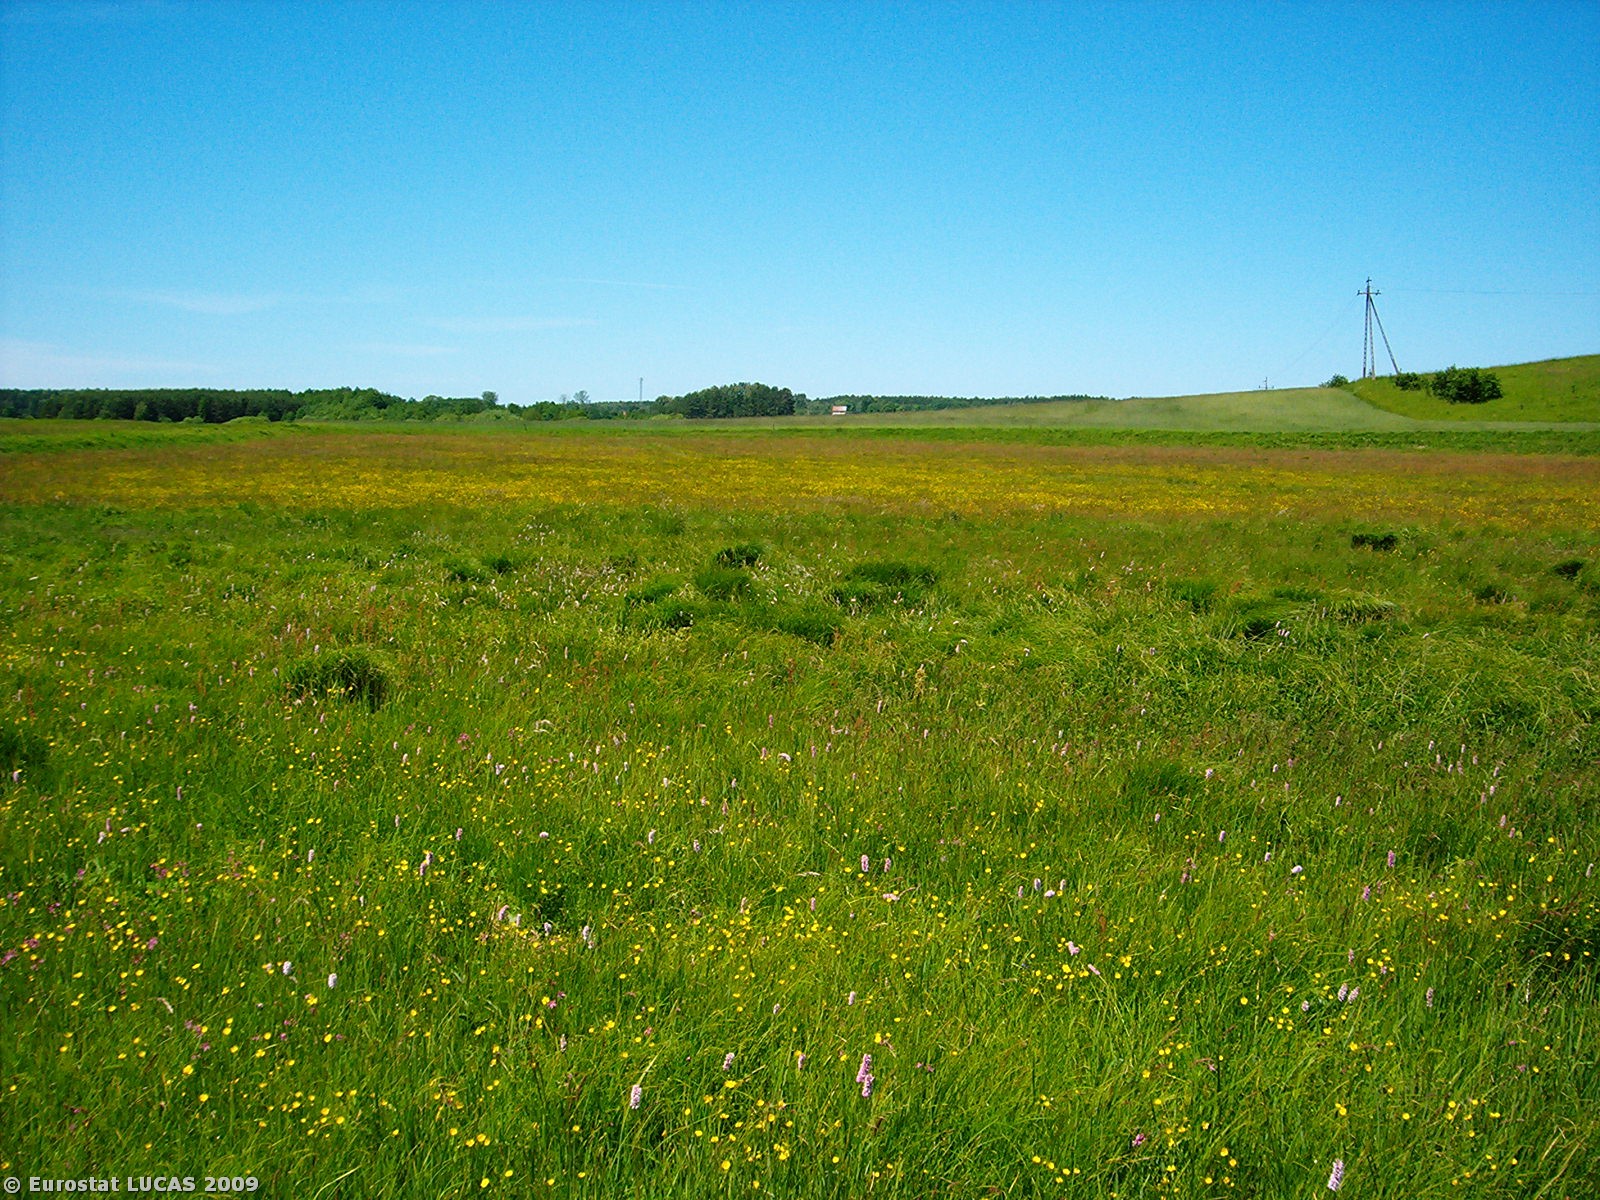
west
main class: Grassland
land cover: Grassland without tree/shrub cover
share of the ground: > 75 %
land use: Unused
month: June
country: PL
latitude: 53.8196
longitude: 17.1946
